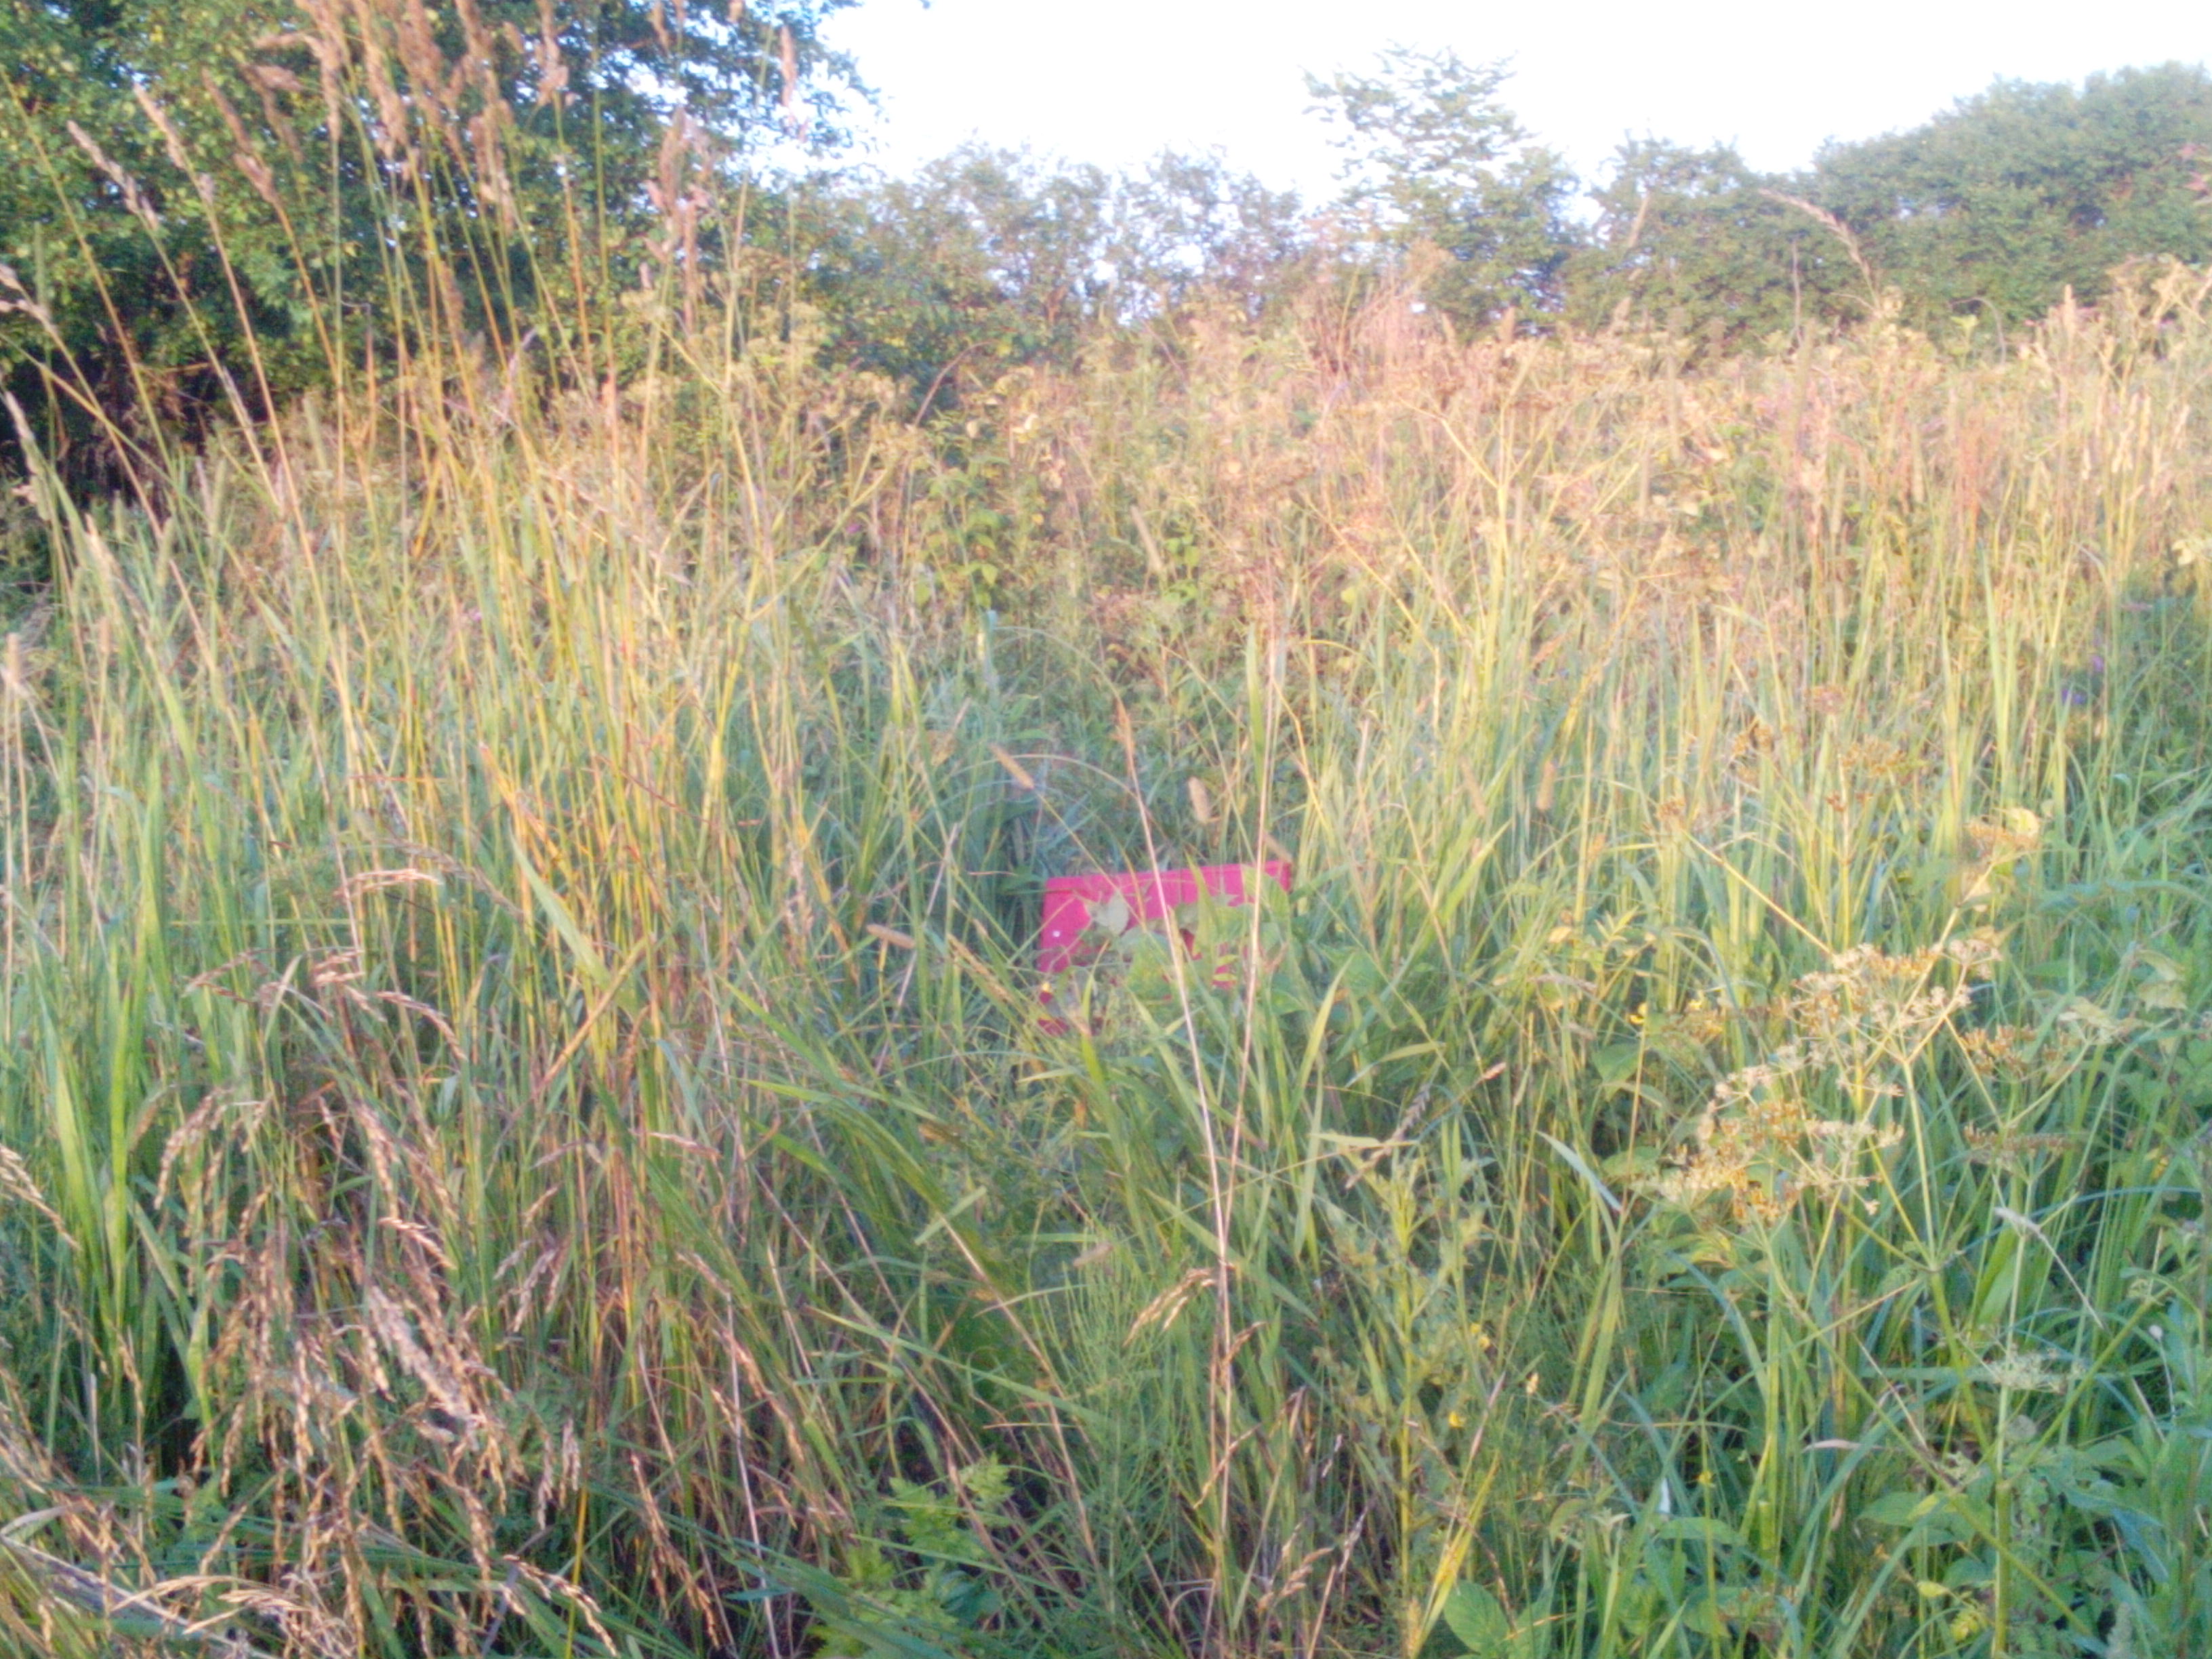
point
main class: Grassland
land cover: Spontaneously vegetated surfaces
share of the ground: > 75 %
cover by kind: herbaceous plants 90 %
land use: Semi-natural and natural areas not in use
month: July
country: LV
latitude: 56.3526
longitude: 21.7791
